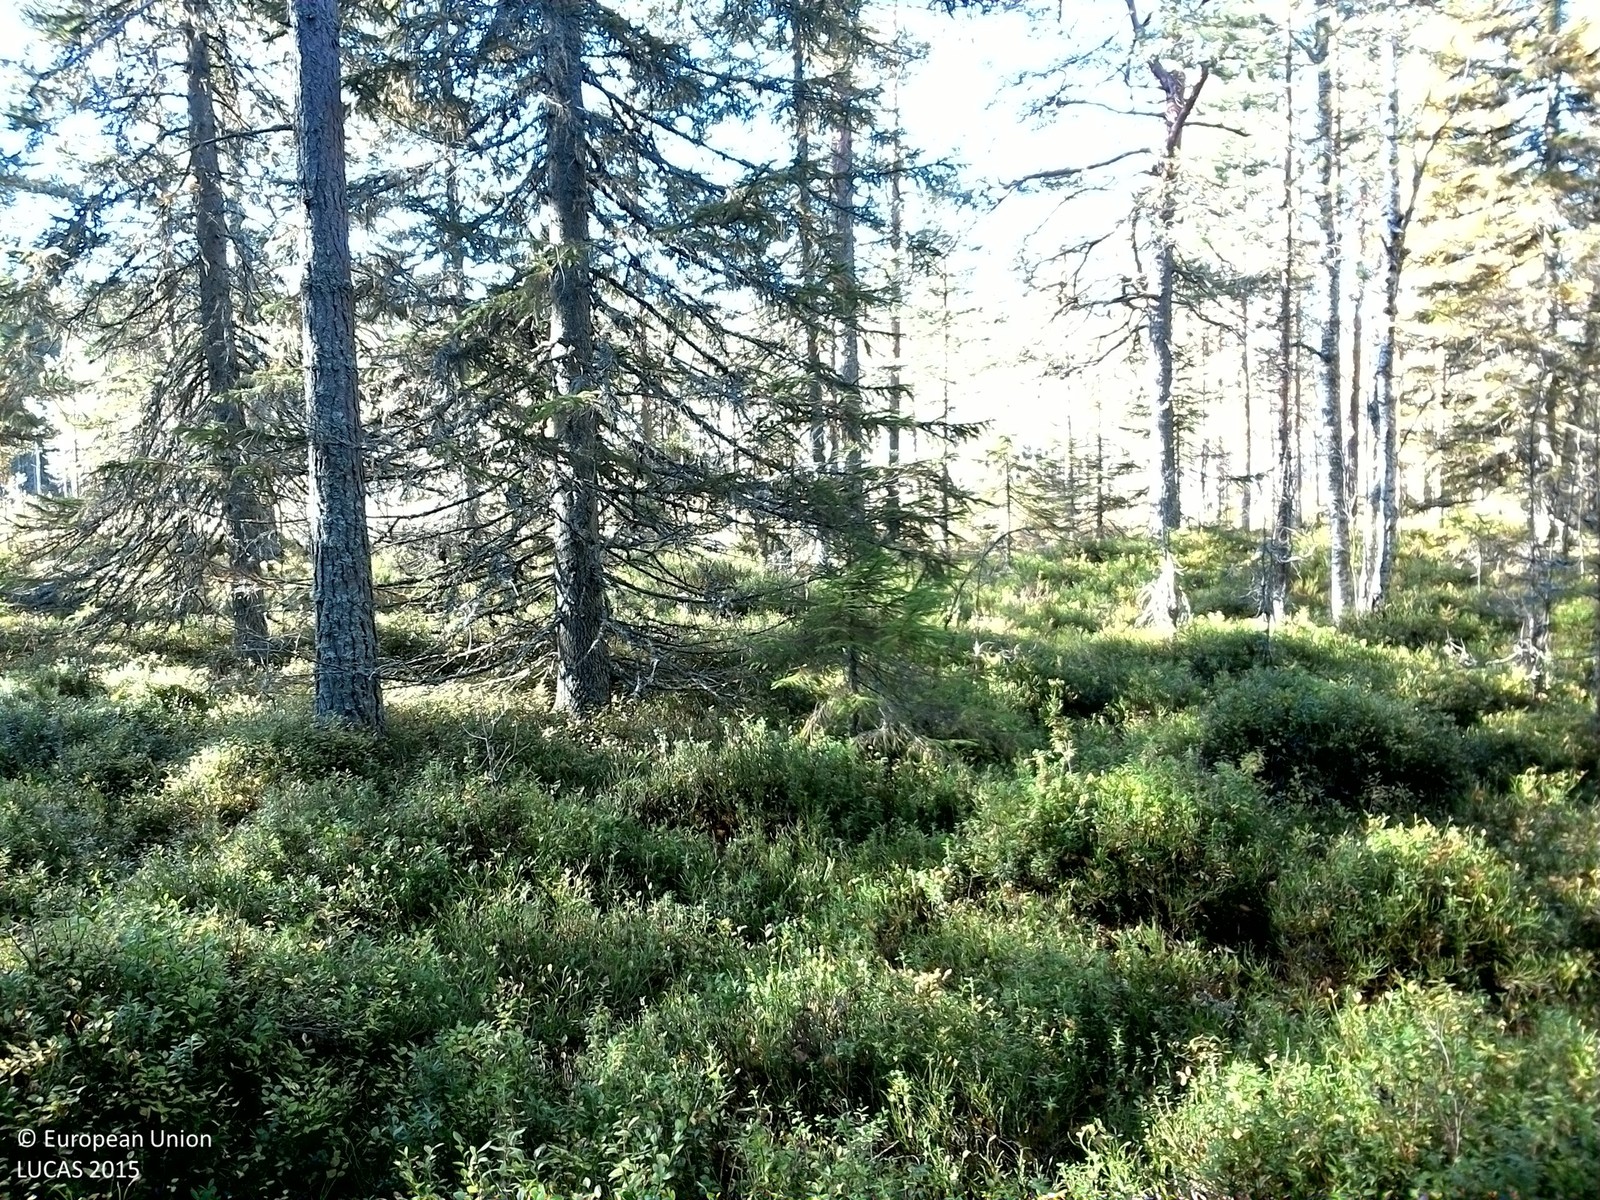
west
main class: Woodland
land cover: Spruce dominated mixed woodland
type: boreal forest
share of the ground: 50 - 75 %
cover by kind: coniferous forest trees 50 %, shrubs 25 %, broadleaved forest trees 20 %, lichens and mosses 5 %
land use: Forestry
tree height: > 5 m
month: October
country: SE
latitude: 61.2366
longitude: 15.2945
